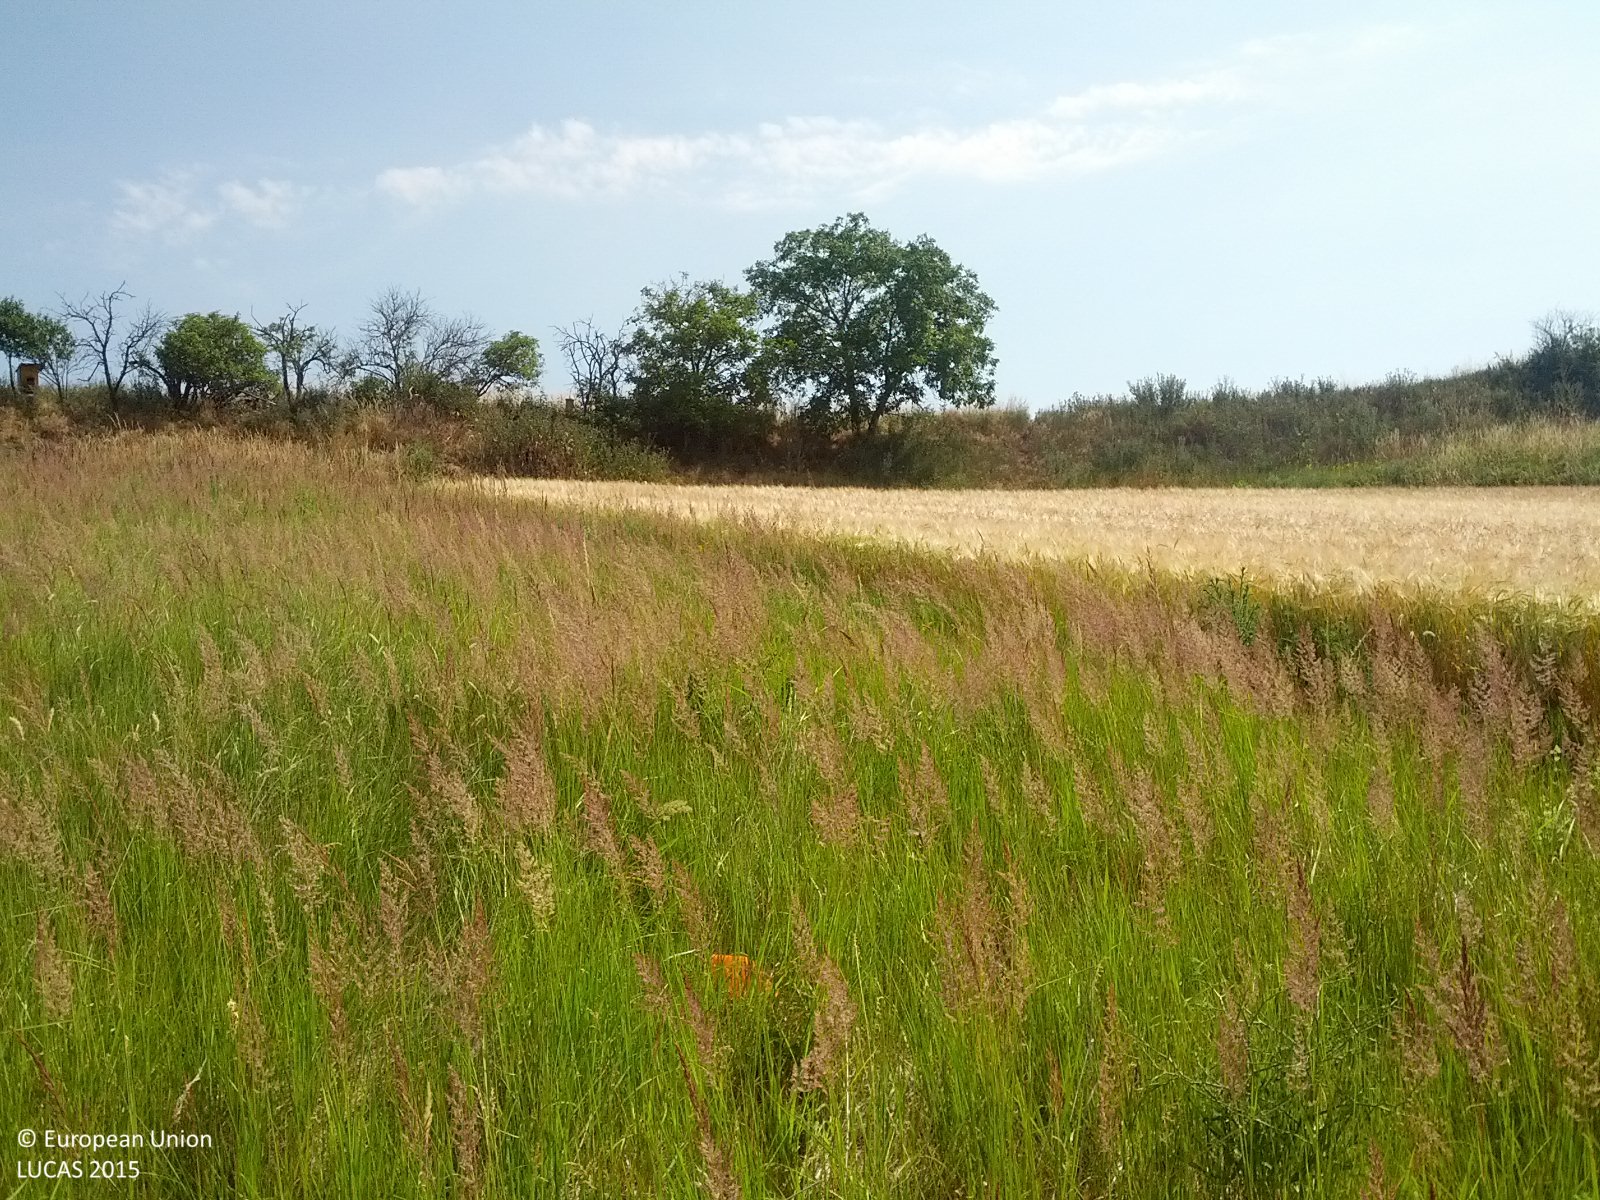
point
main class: Grassland
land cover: Grassland without tree/shrub cover
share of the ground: > 75 %
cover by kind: herbaceous plants 100 %
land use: Agriculture (excluding fallow land and kitchen gardens)
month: July
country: AT
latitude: 48.6695
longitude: 16.7016
